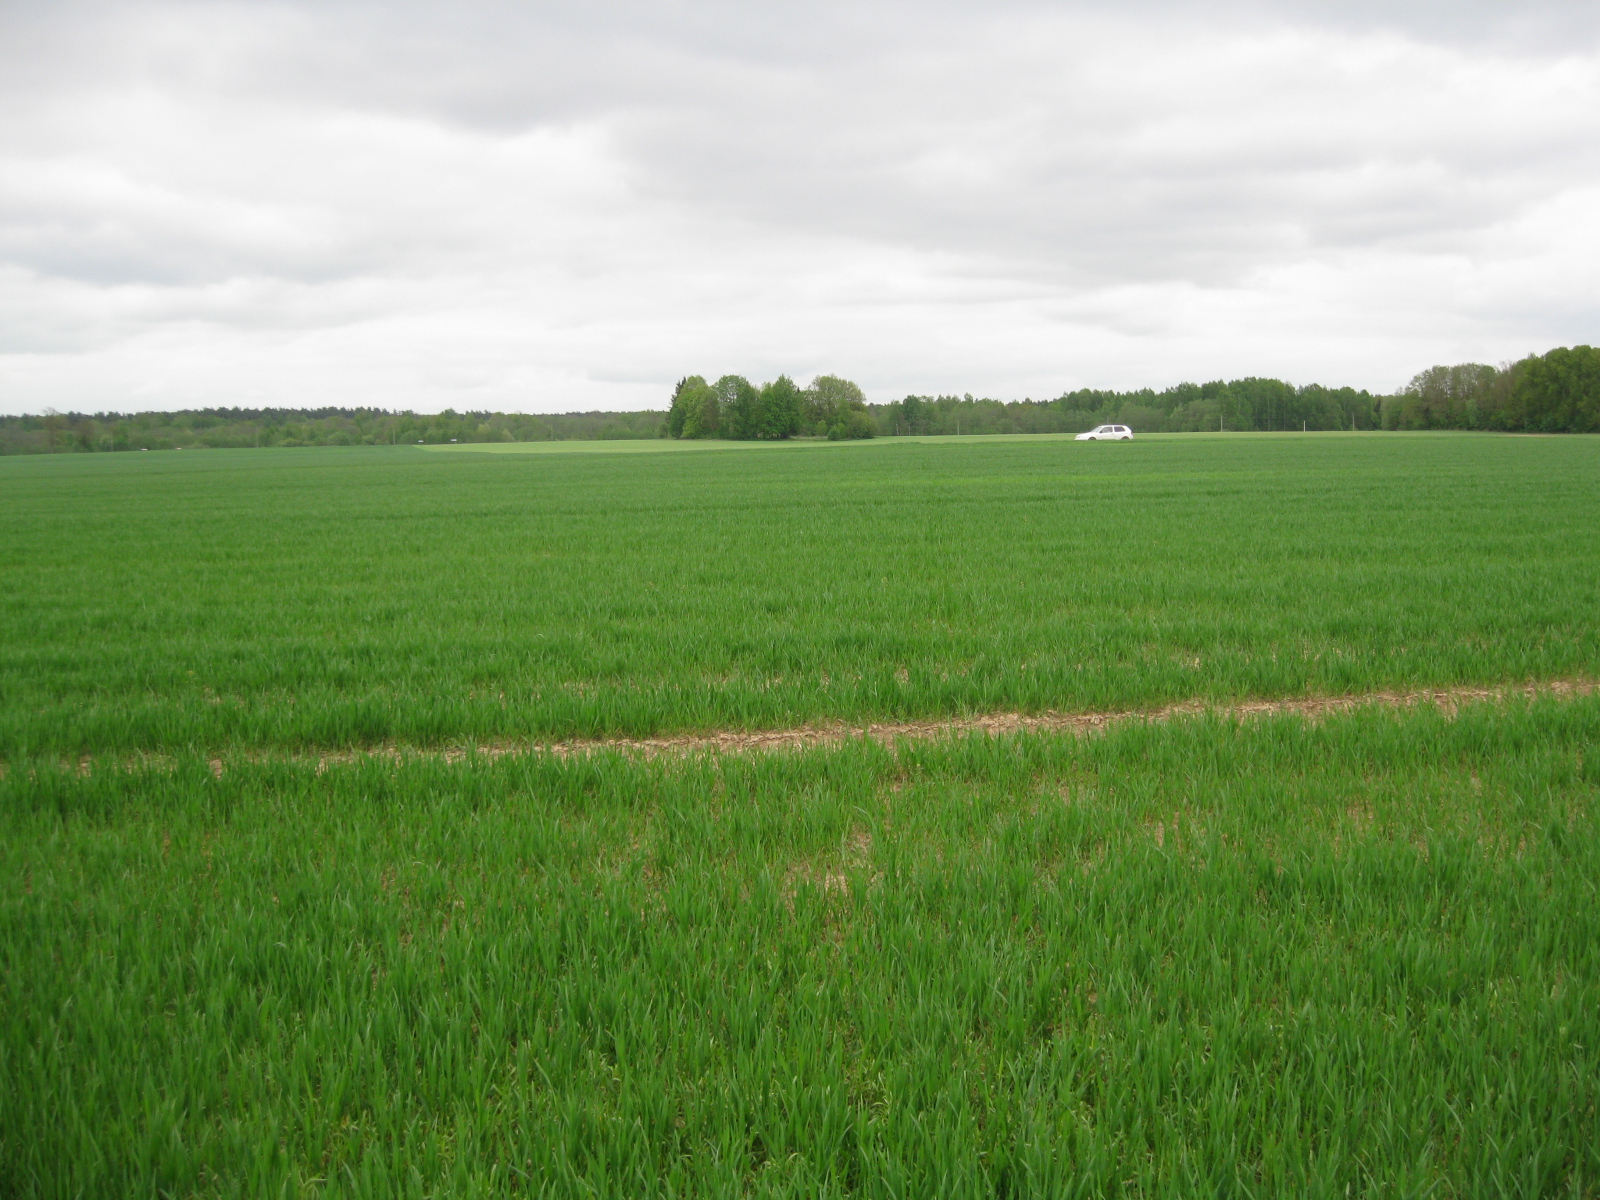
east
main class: Cropland
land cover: Common wheat
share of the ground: > 75 %
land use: Agriculture (excluding fallow land and kitchen gardens)
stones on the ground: < 10 %
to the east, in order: Common wheat
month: May
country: LT
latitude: 56.0079
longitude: 24.4182
